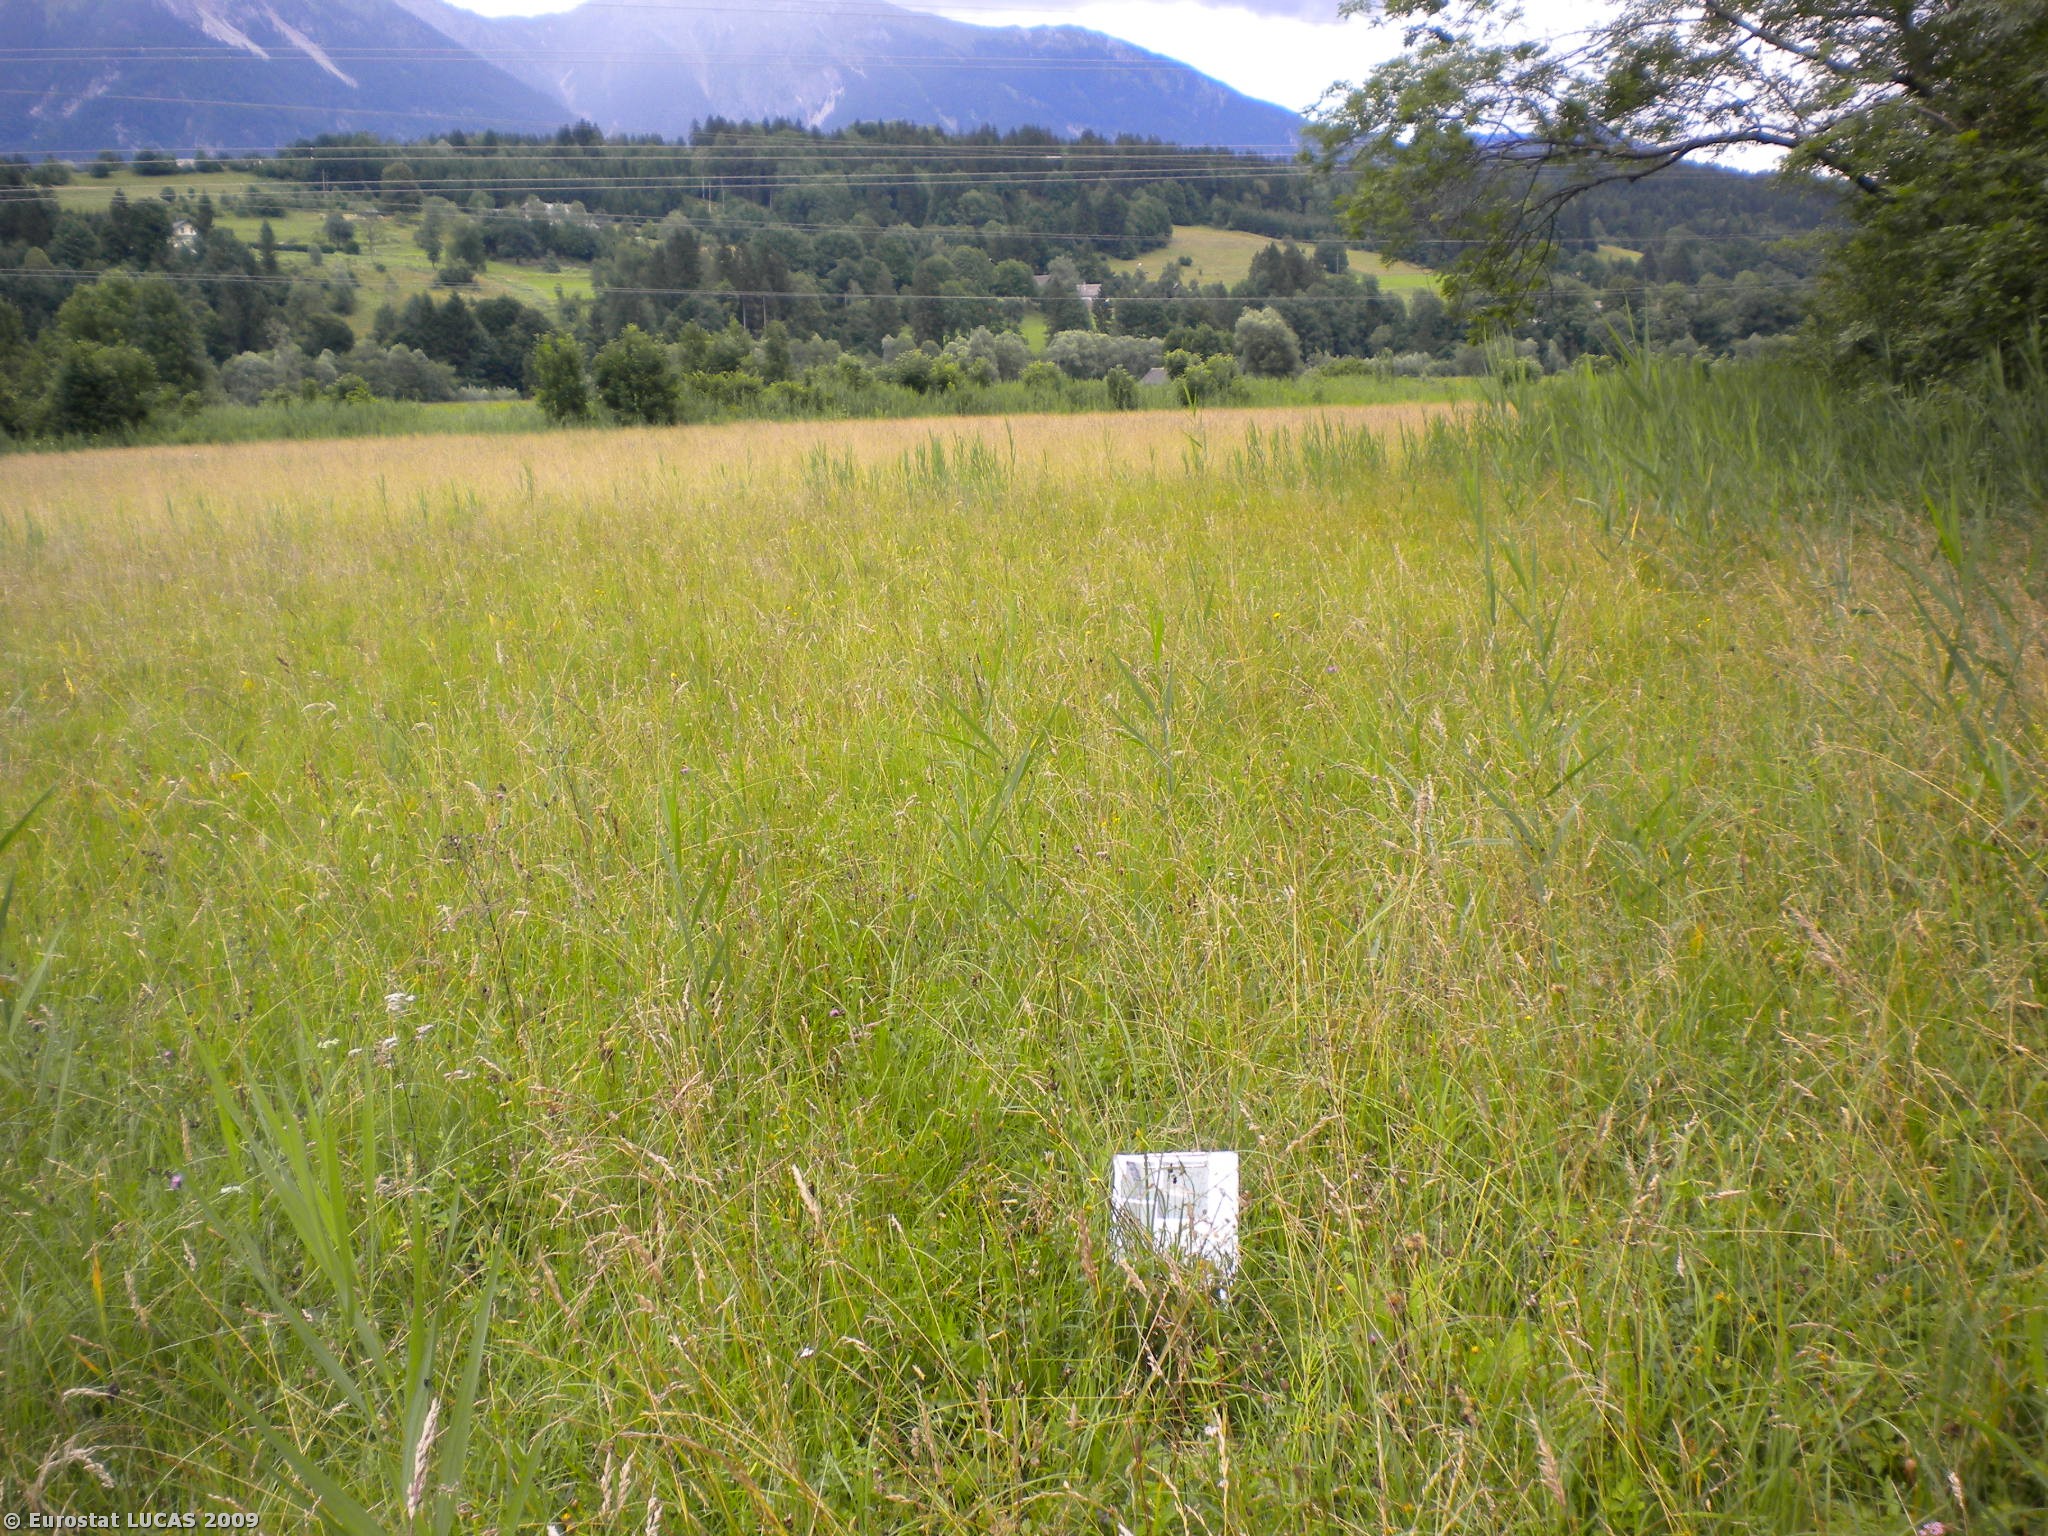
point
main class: Grassland
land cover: Grassland without tree/shrub cover
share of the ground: > 75 %
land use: Agriculture (excluding fallow land and kitchen gardens)
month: July
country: AT
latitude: 46.6035
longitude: 13.4045
